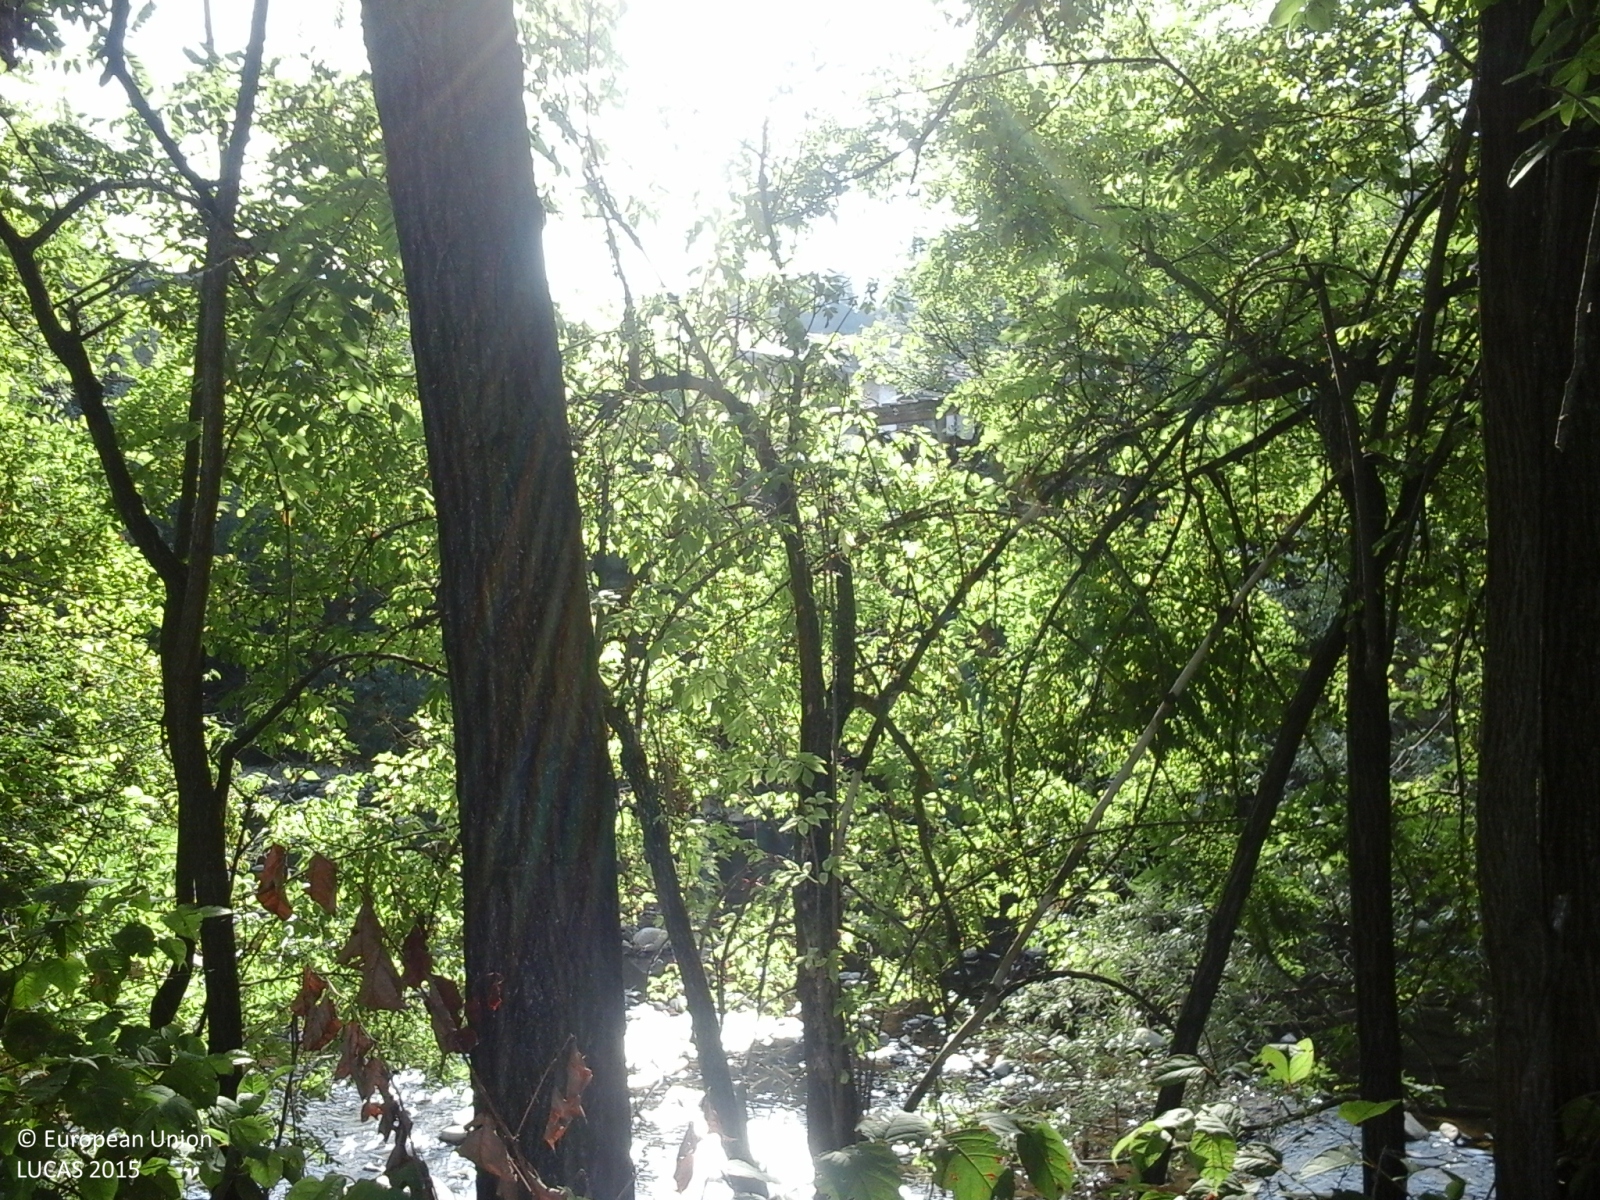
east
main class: Woodland
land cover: Broadleaved woodland
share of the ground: > 75 %
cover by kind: broadleaved forest trees 95 %, shrubs 5 %
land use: Semi-natural and natural areas not in use
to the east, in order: Inland fresh running water; Broadleaved woodland; Artificial constructions in urban areas; Grassland without tree/shrub cover; Abandoned hedges; Paved roads, cycling and walking lanes; Broadleaved woodland; Inland fresh running water; Broadleaved woodland
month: August
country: IT
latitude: 44.4001
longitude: 7.8325
